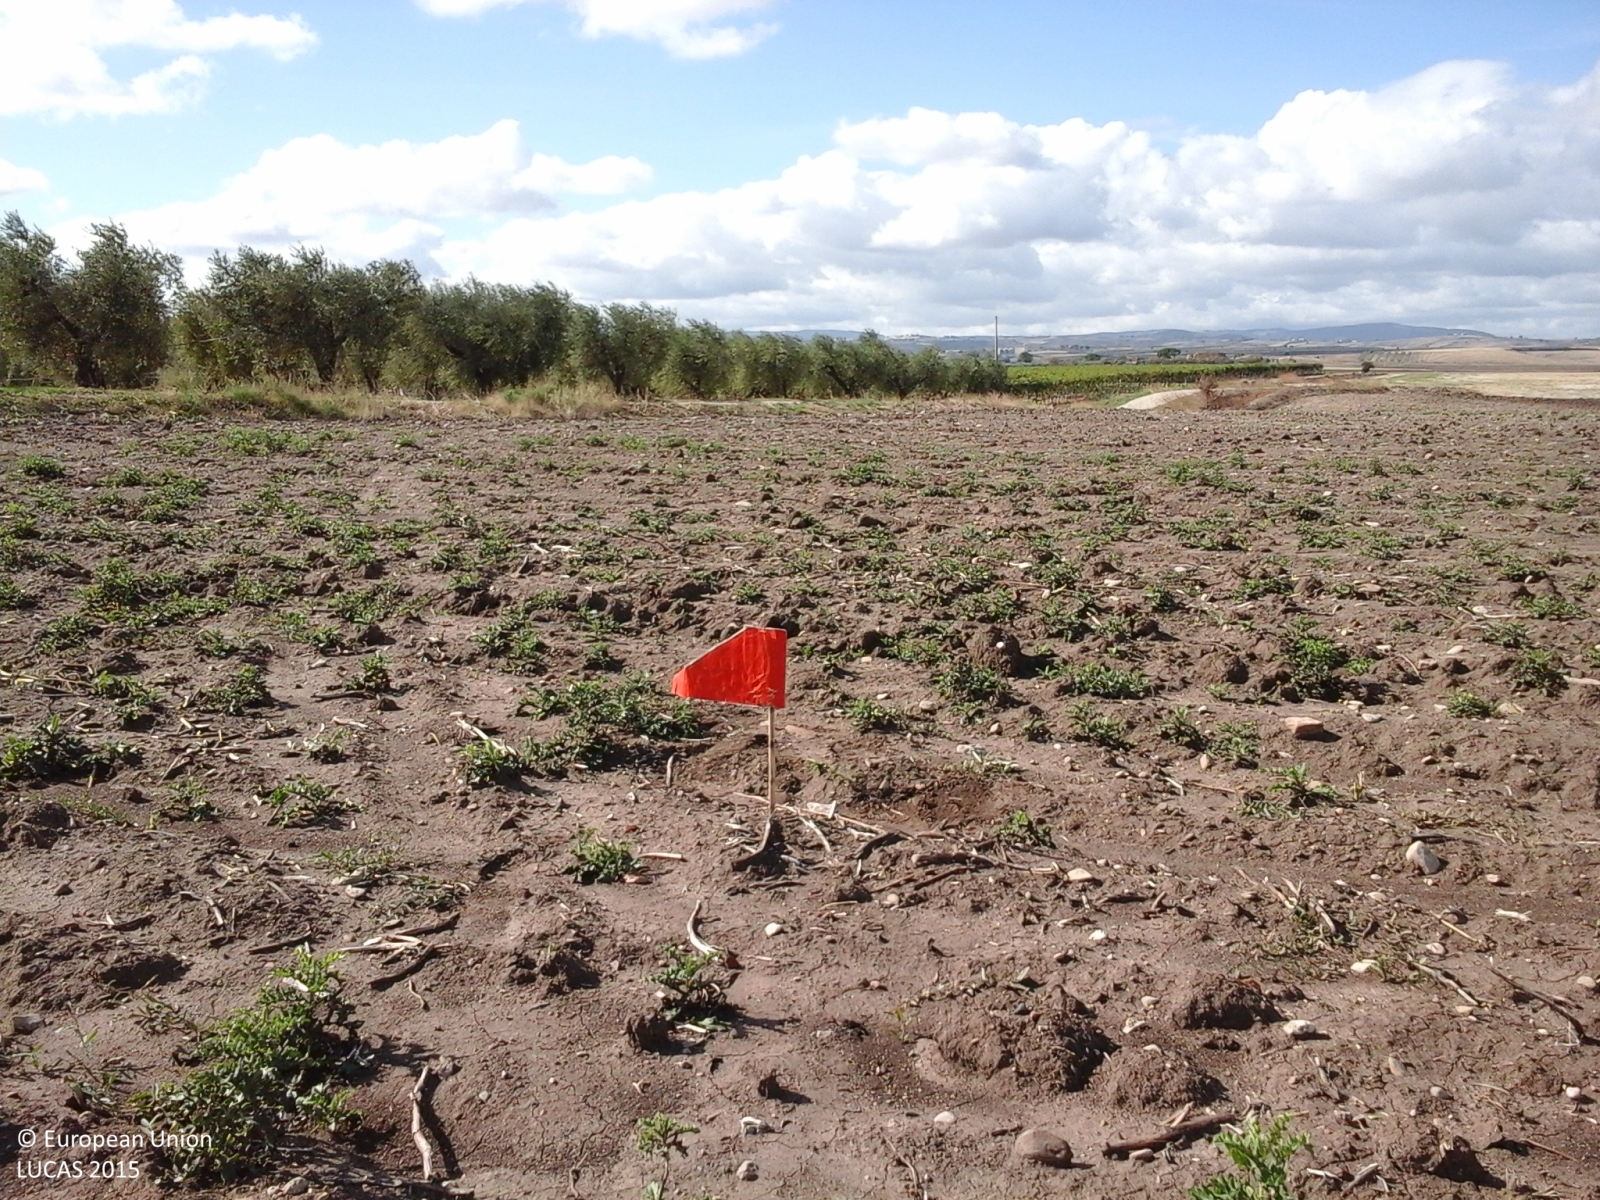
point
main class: Cropland
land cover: Dry pulses
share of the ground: > 75 %
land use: Agriculture (excluding fallow land and kitchen gardens)
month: September
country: IT
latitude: 41.6898
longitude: 15.1617
